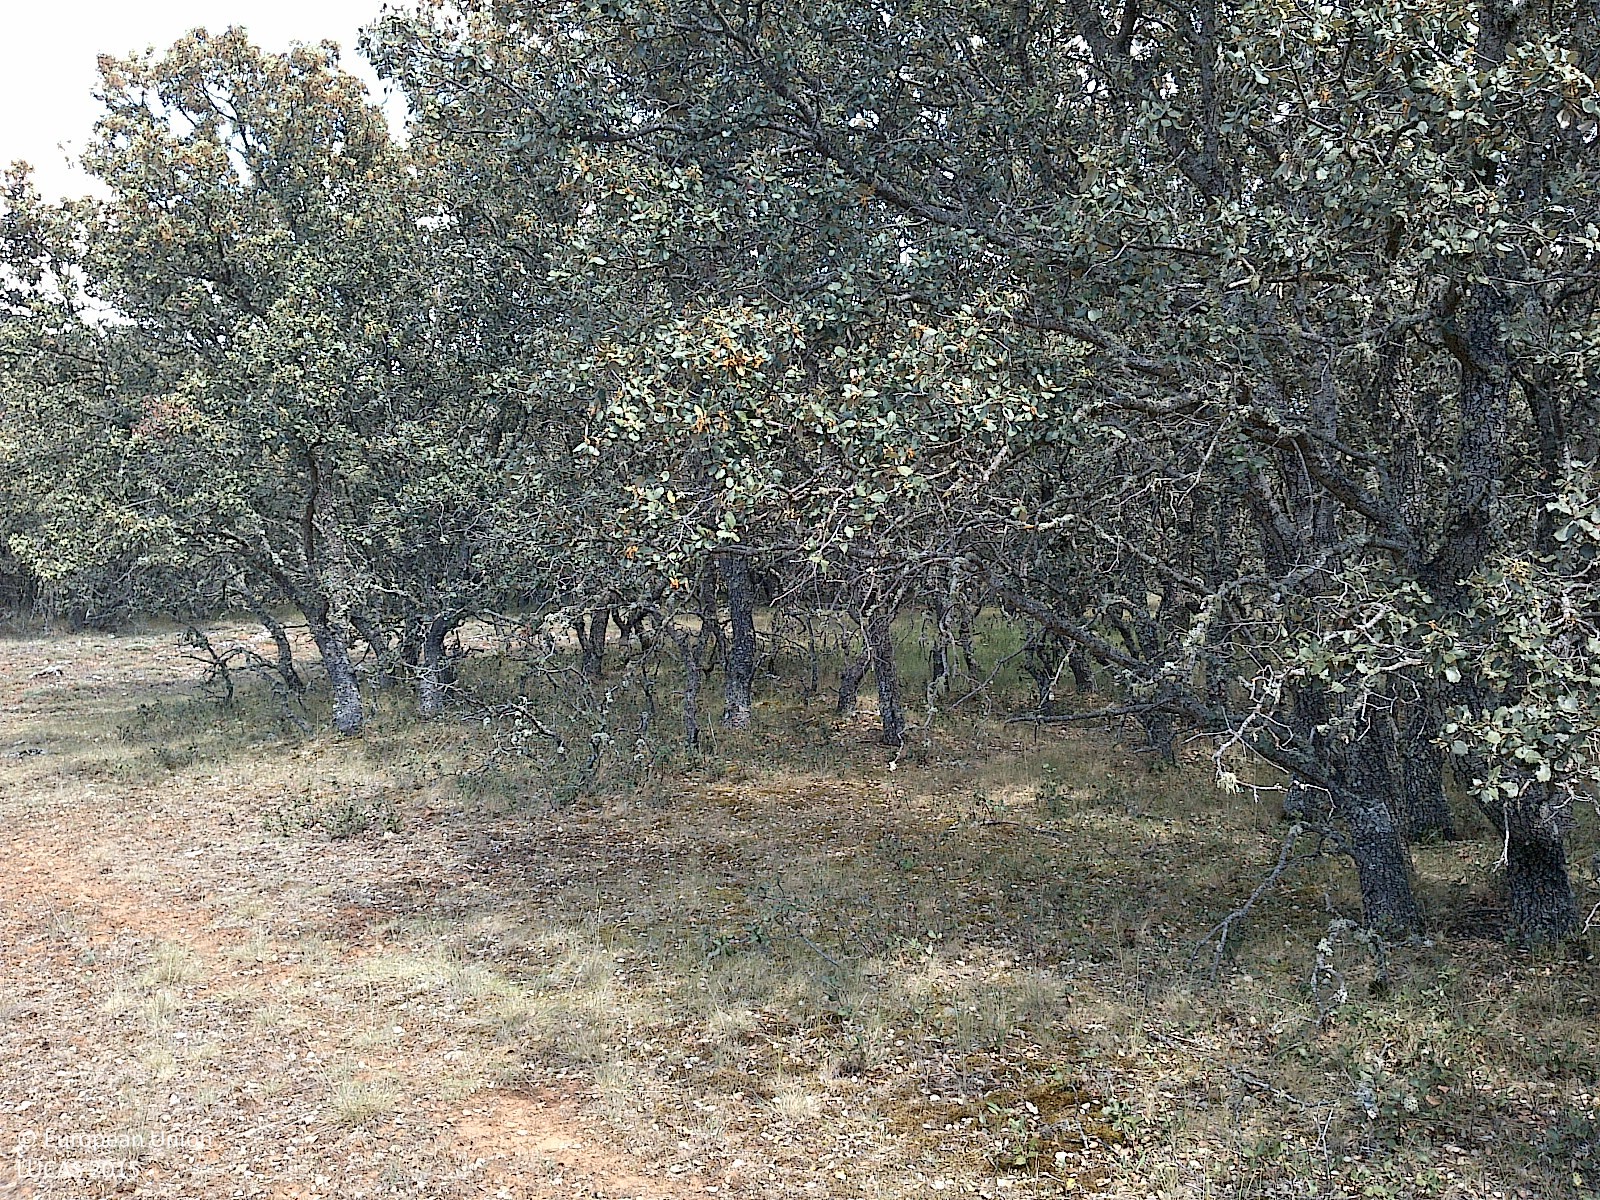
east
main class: Woodland
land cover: Broadleaved woodland
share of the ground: 50 - 75 %
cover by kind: broadleaved forest trees 50 %, herbaceous plants 40 %, consolidated bare surface 5 %, unconsolidated bare surface 5 %
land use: Forestry
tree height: < 5 m
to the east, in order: Broadleaved woodland
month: June
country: ES
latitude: 41.7175
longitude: -2.1621
